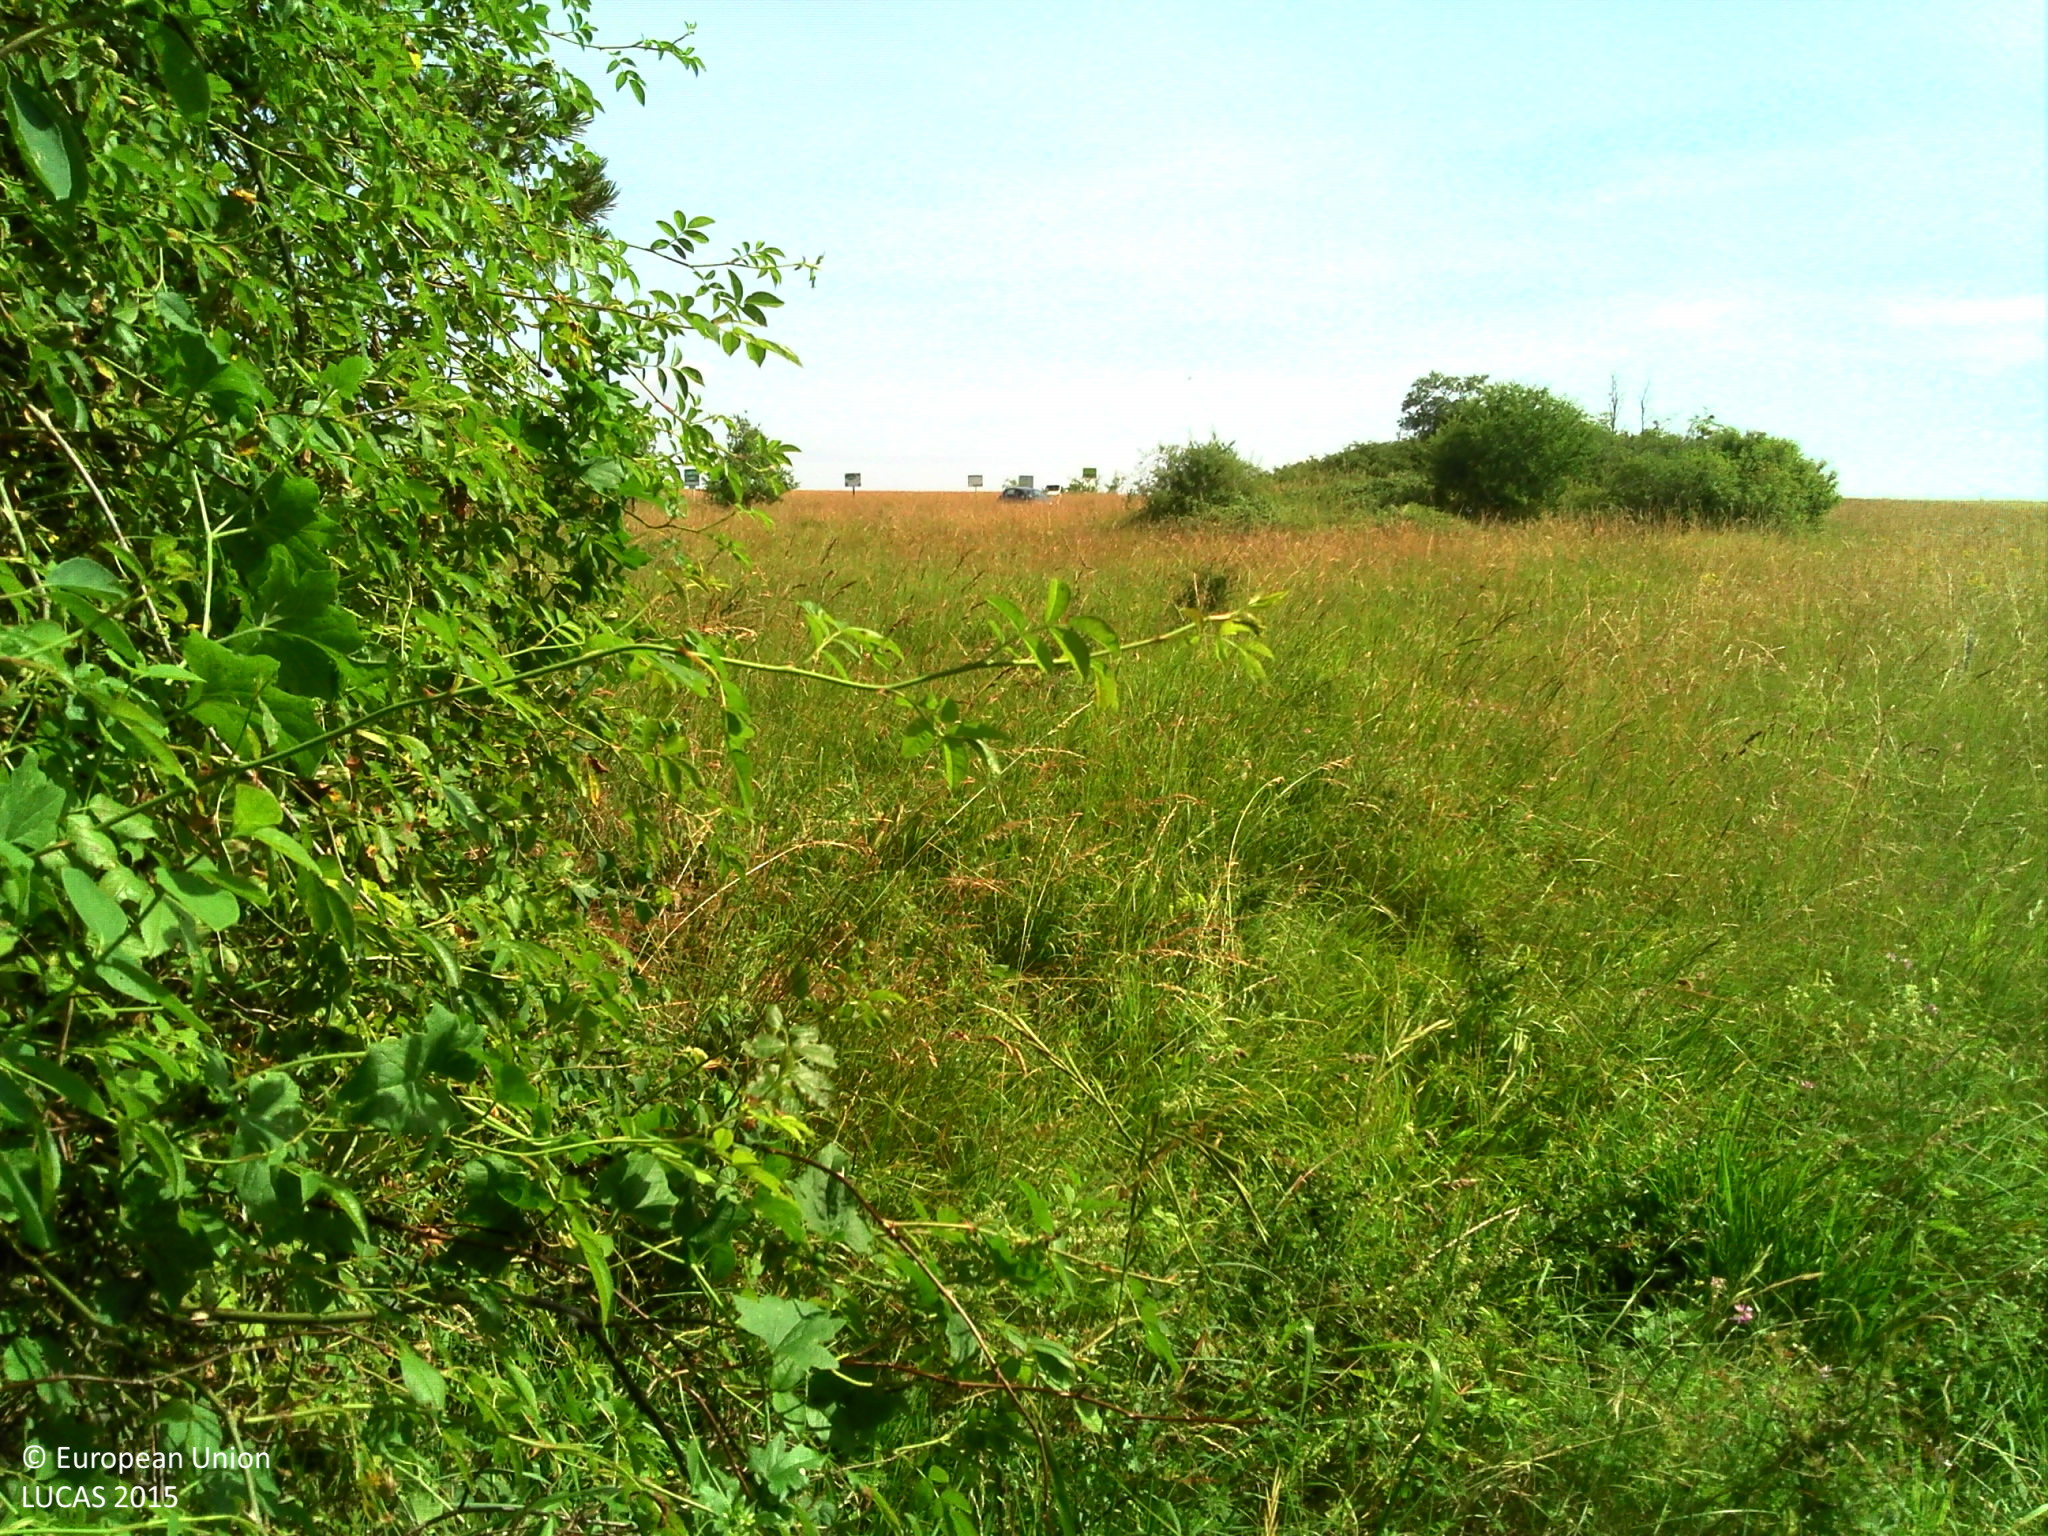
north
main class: Woodland
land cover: Pine dominated mixed woodland
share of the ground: 25 - 50 %
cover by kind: coniferous forest trees 50 %, broadleaved forest trees 30 %, shrubs 10 %, herbaceous plants 10 %
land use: Semi-natural and natural areas not in use
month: June
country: FR
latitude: 47.4350
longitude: 3.4862
